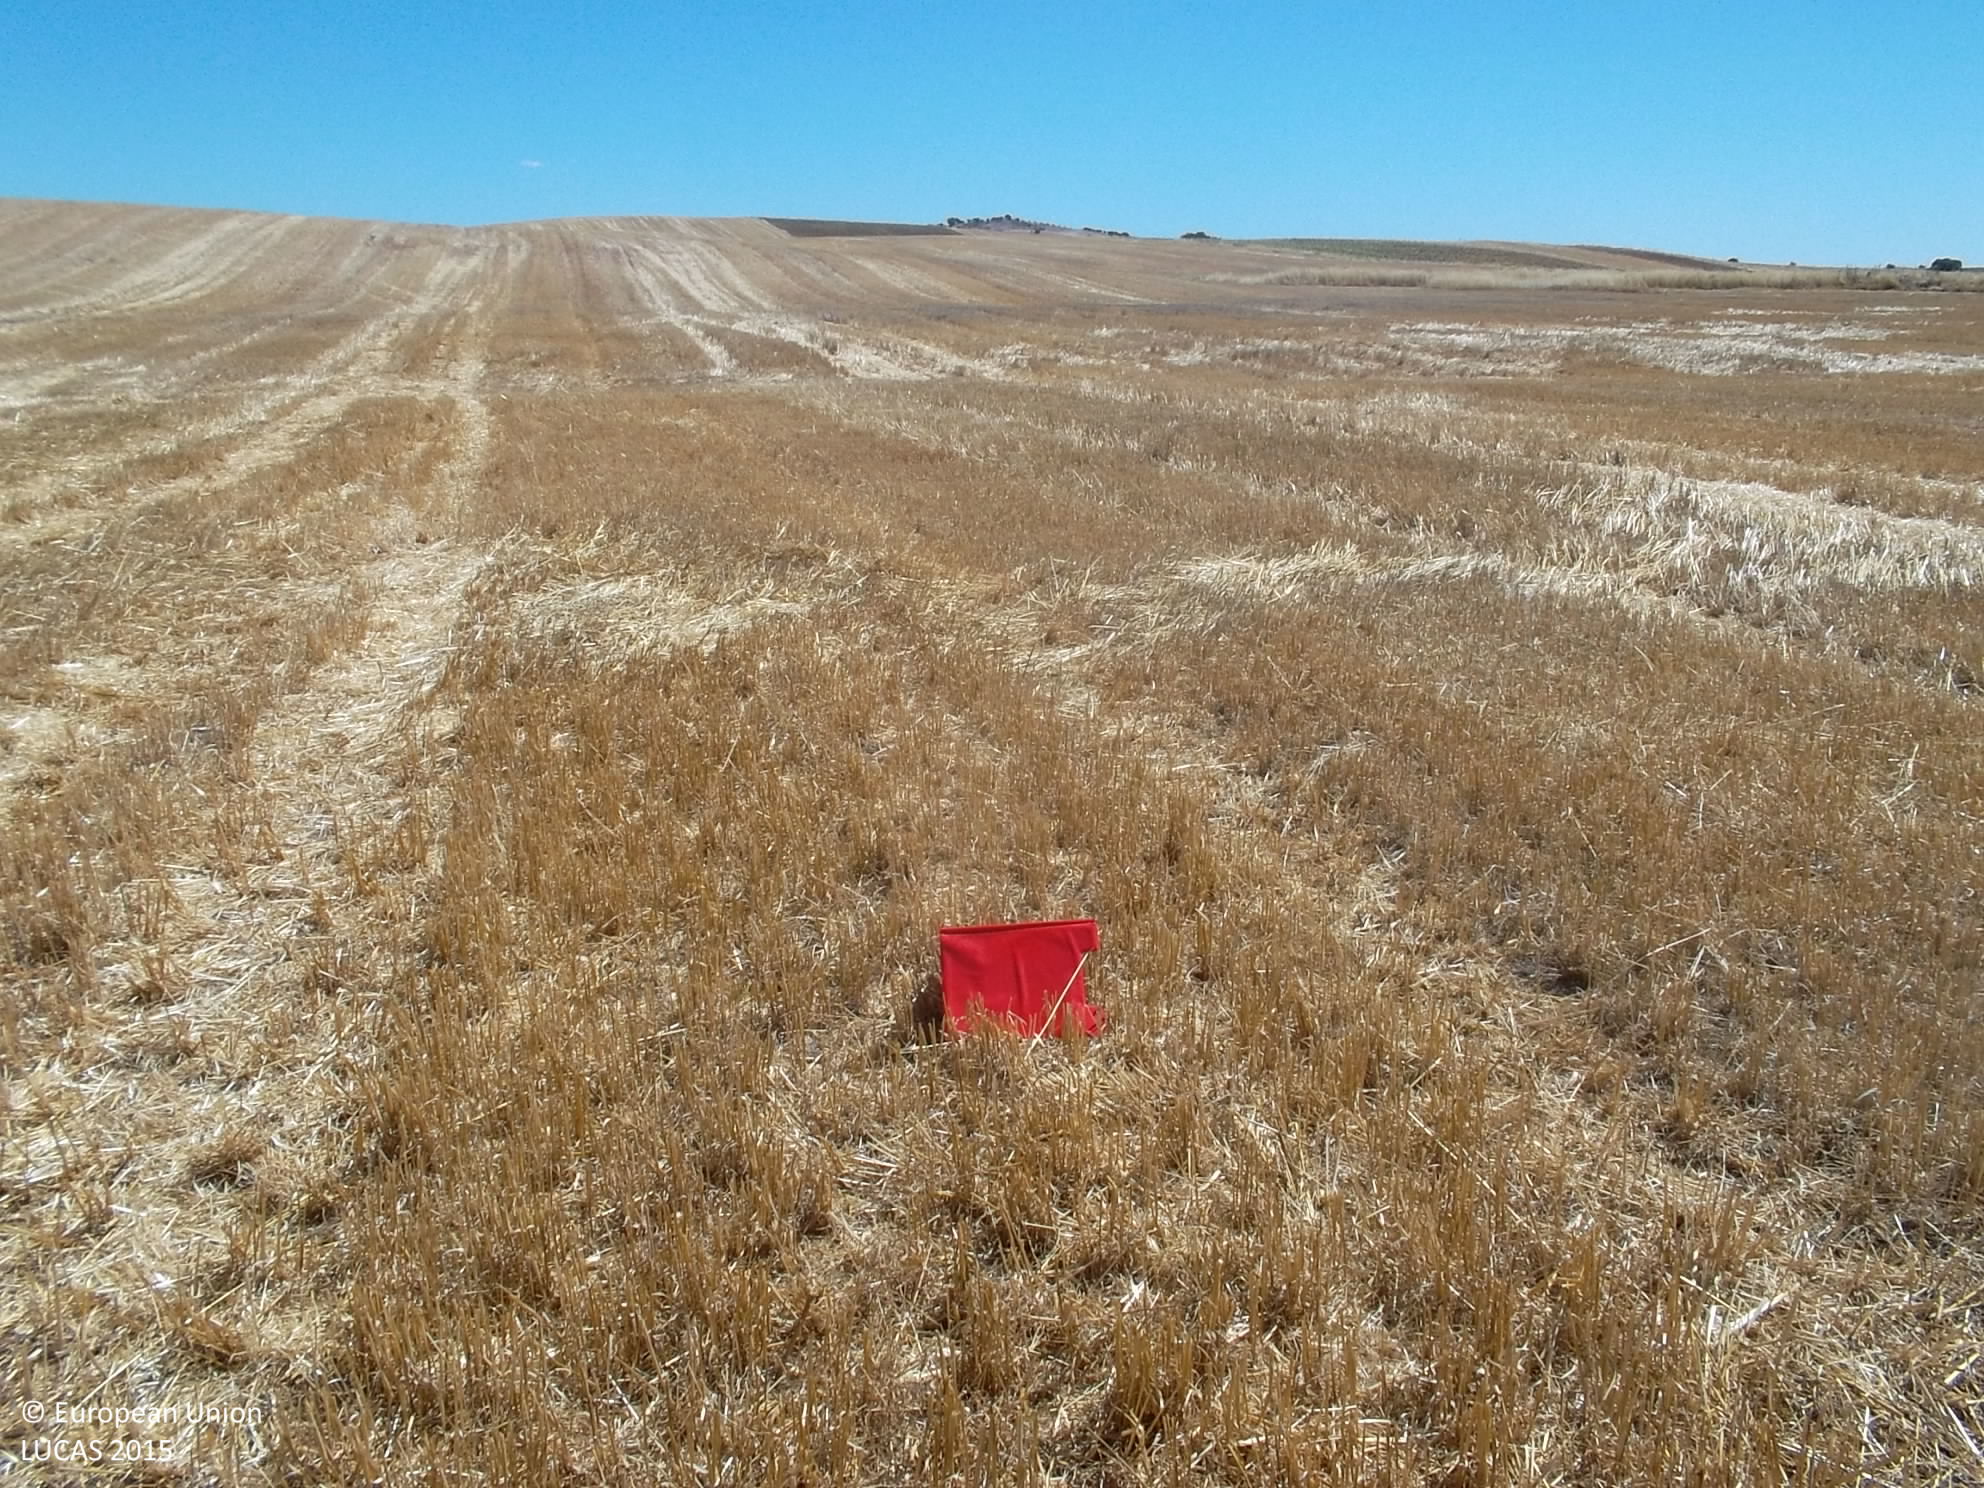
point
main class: Cropland
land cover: Barley
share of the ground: < 10 %
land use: Agriculture (excluding fallow land and kitchen gardens)
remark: Harvested field
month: July
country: ES
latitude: 38.4173
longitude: -5.7405
